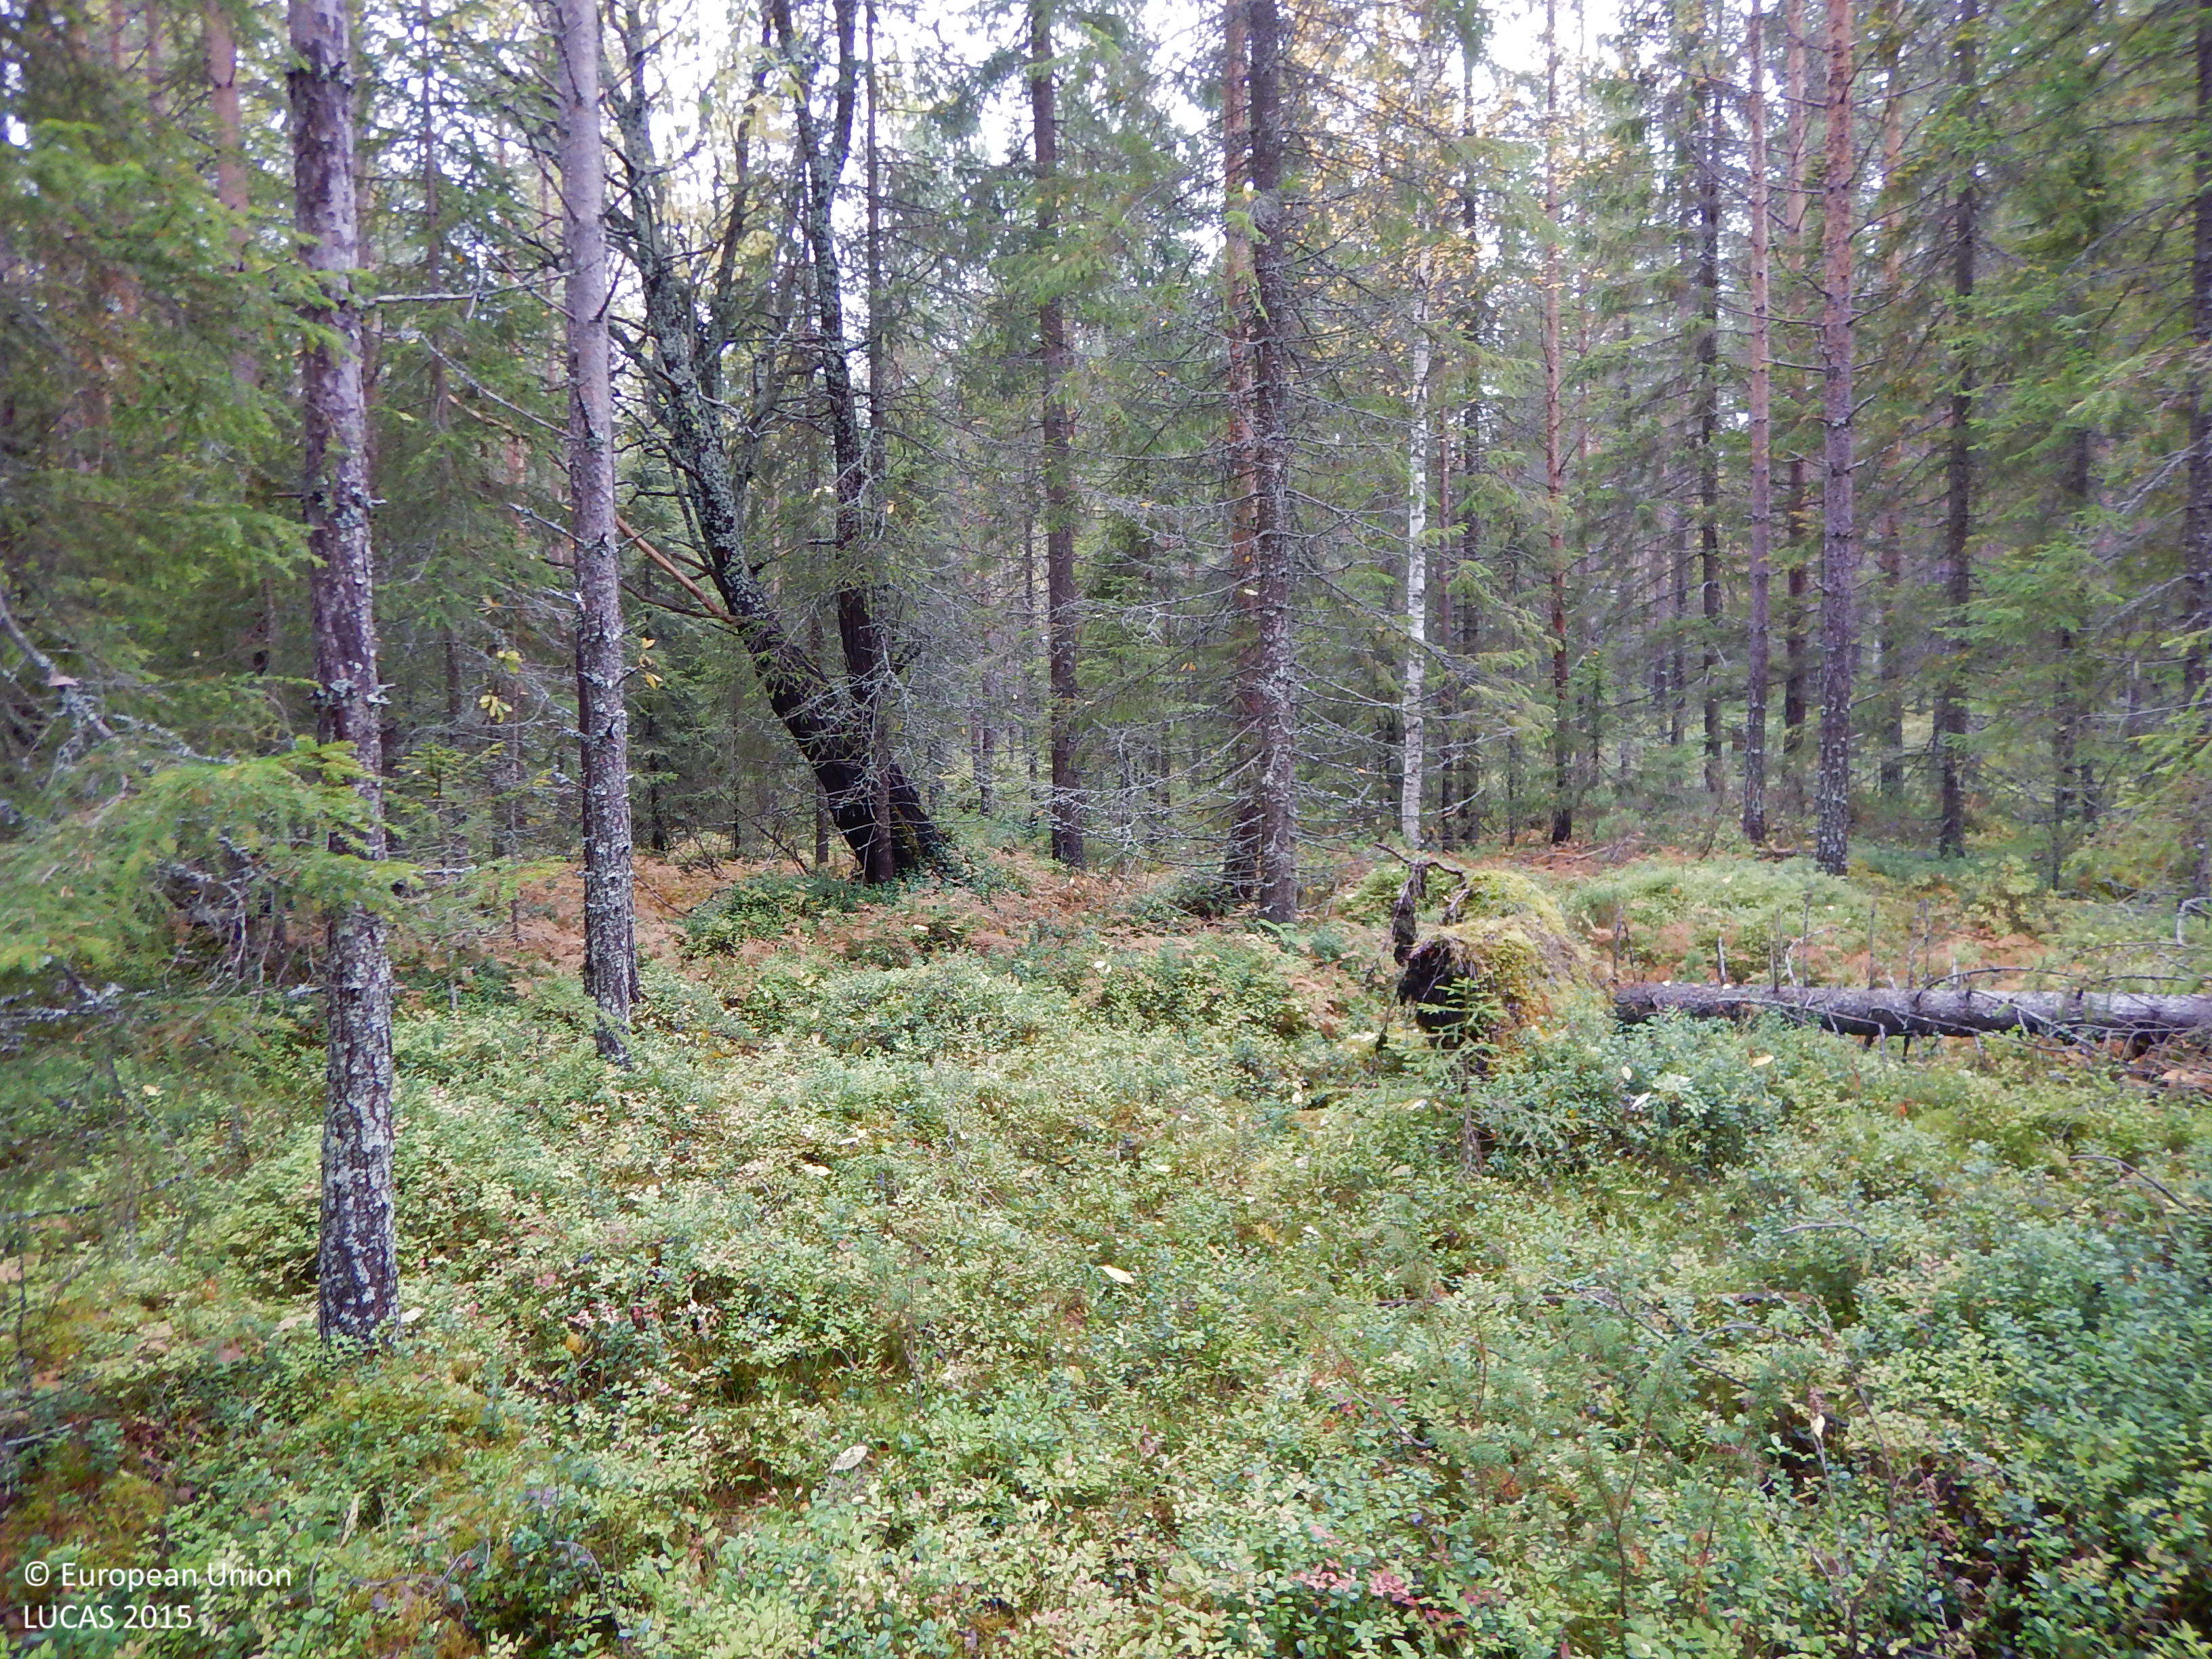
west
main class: Woodland
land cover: Pine dominated coniferous woodland
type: boreal forest
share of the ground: 50 - 75 %
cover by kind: coniferous forest trees 60 %, shrubs 20 %, lichens and mosses 20 %
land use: Forestry
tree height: > 5 m
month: September
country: SE
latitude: 65.1326
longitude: 19.1930
